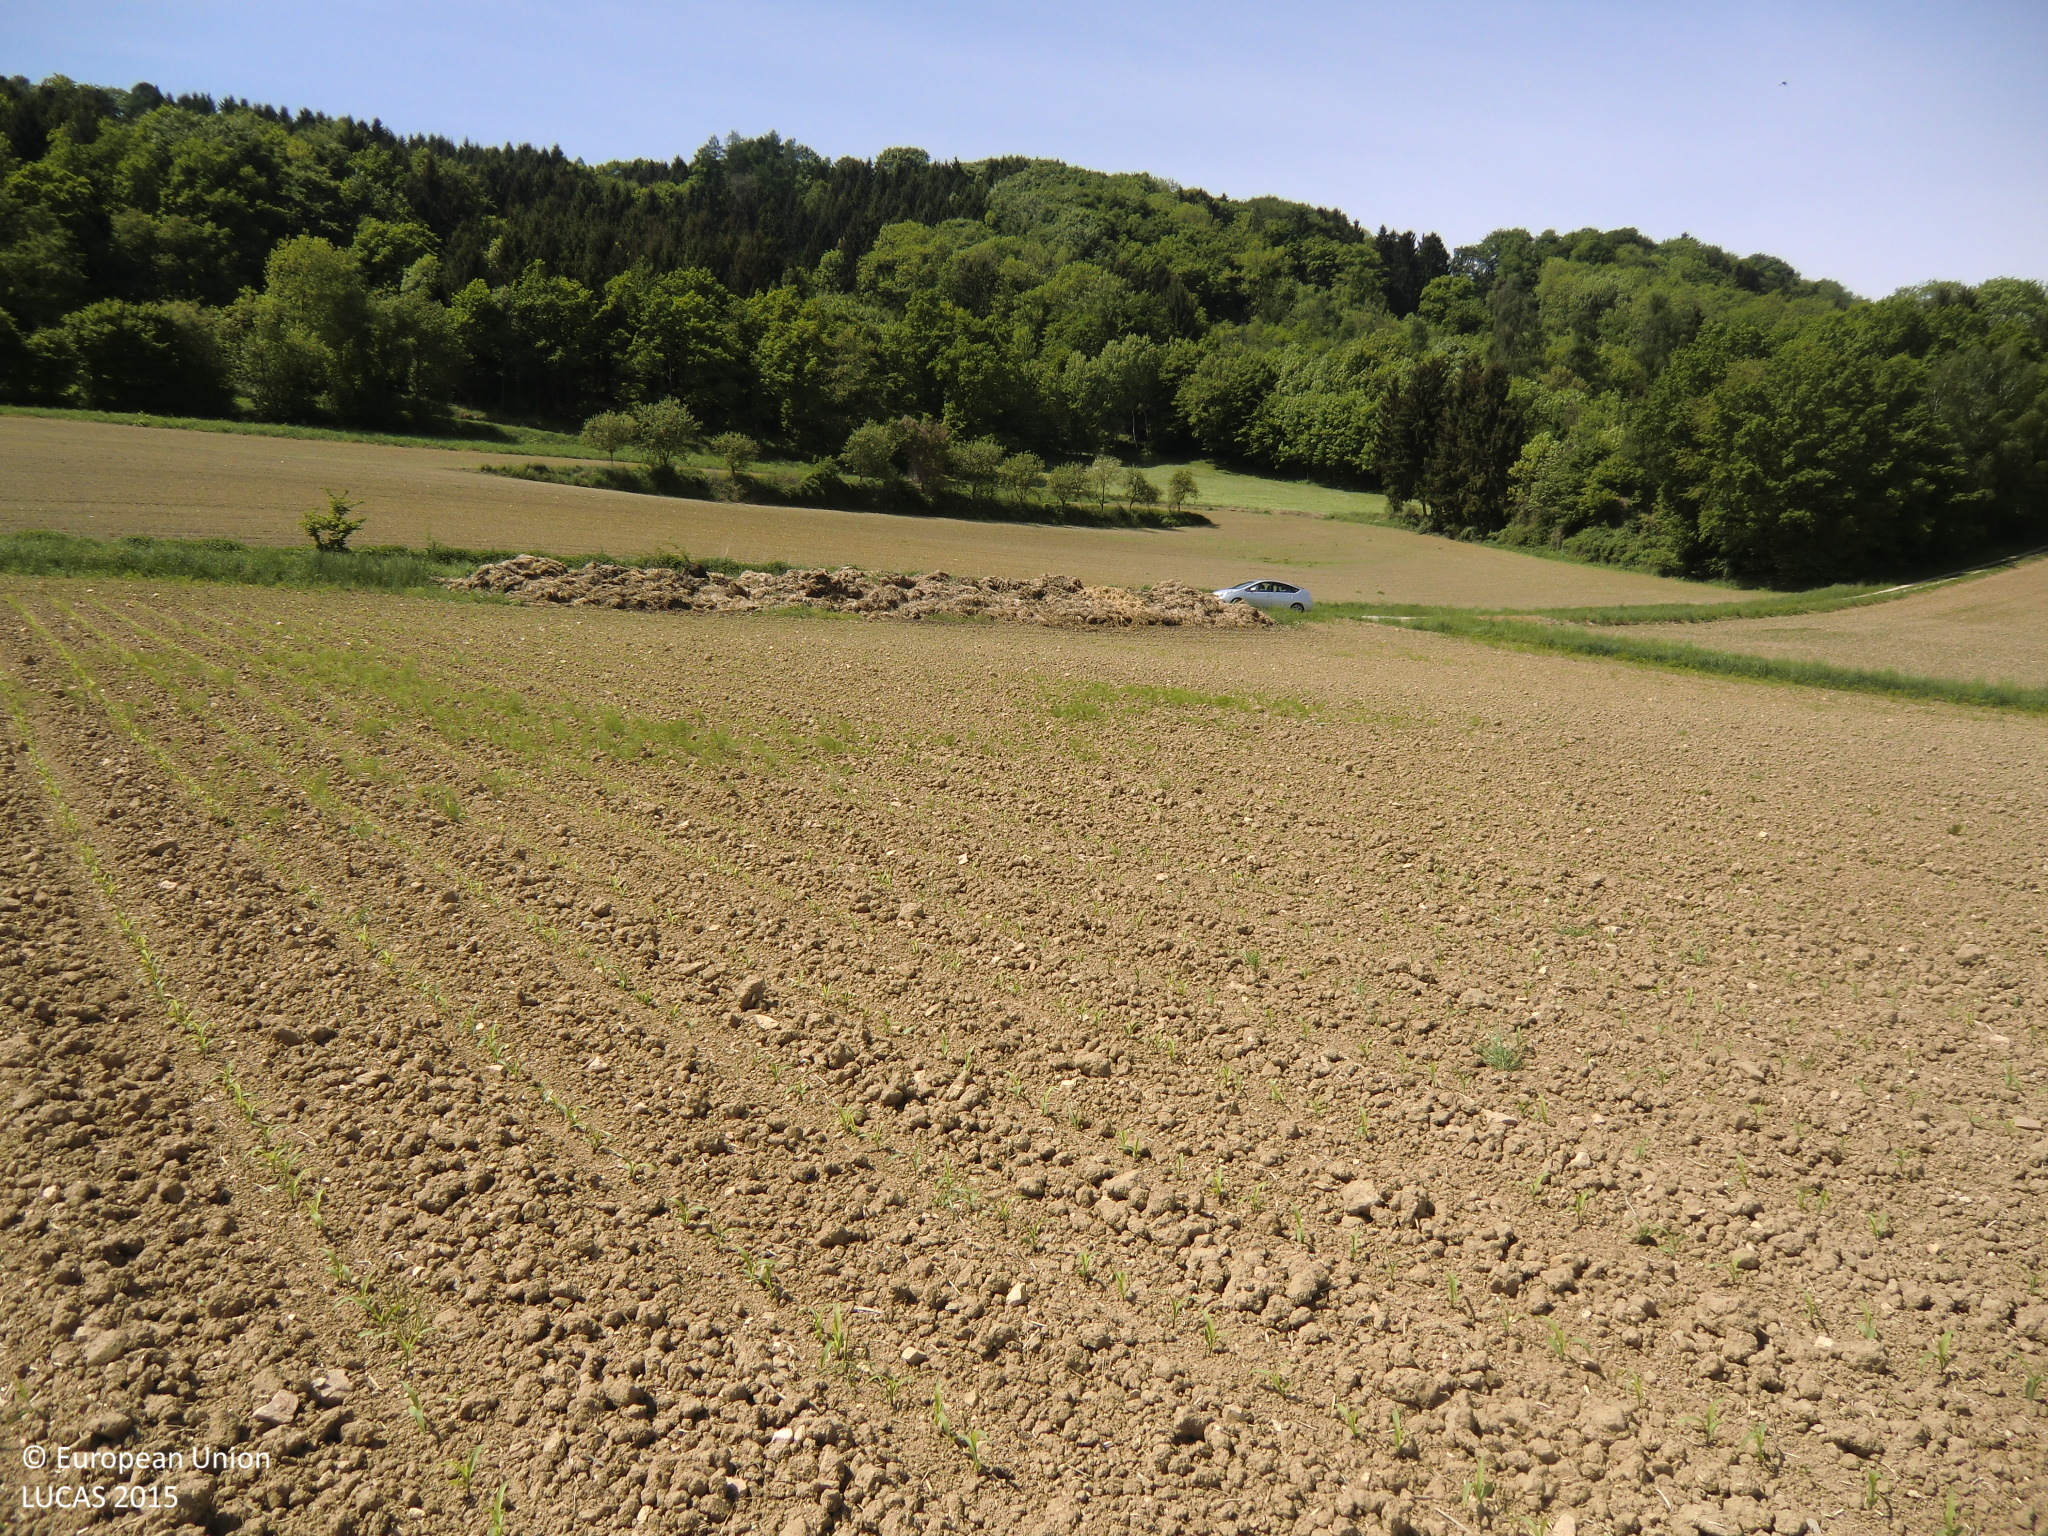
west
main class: Cropland
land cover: Maize
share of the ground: 25 - 50 %
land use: Agriculture (excluding fallow land and kitchen gardens)
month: May
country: AT
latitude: 48.1829
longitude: 15.3685
